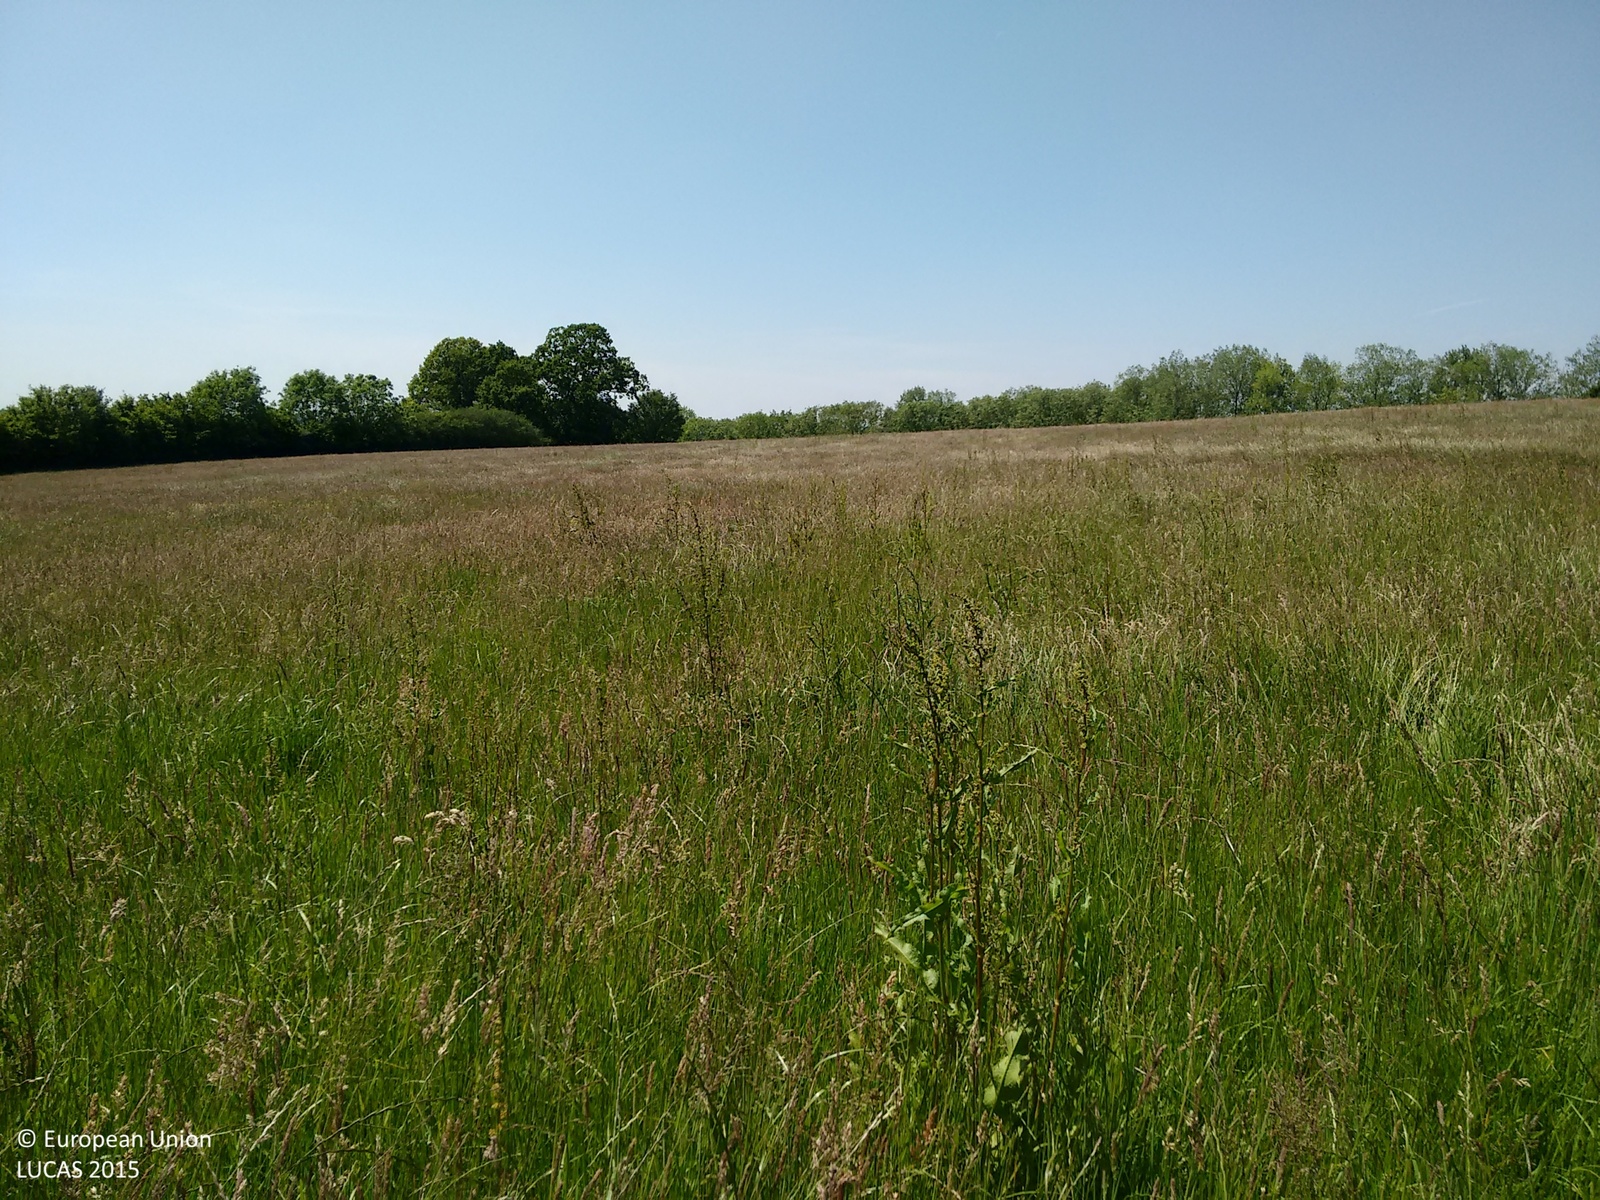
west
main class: Grassland
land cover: Grassland without tree/shrub cover
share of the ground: > 75 %
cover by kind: herbaceous plants 100 %
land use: Agriculture (excluding fallow land and kitchen gardens)
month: June
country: GB
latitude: 51.0460
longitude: 0.4002
